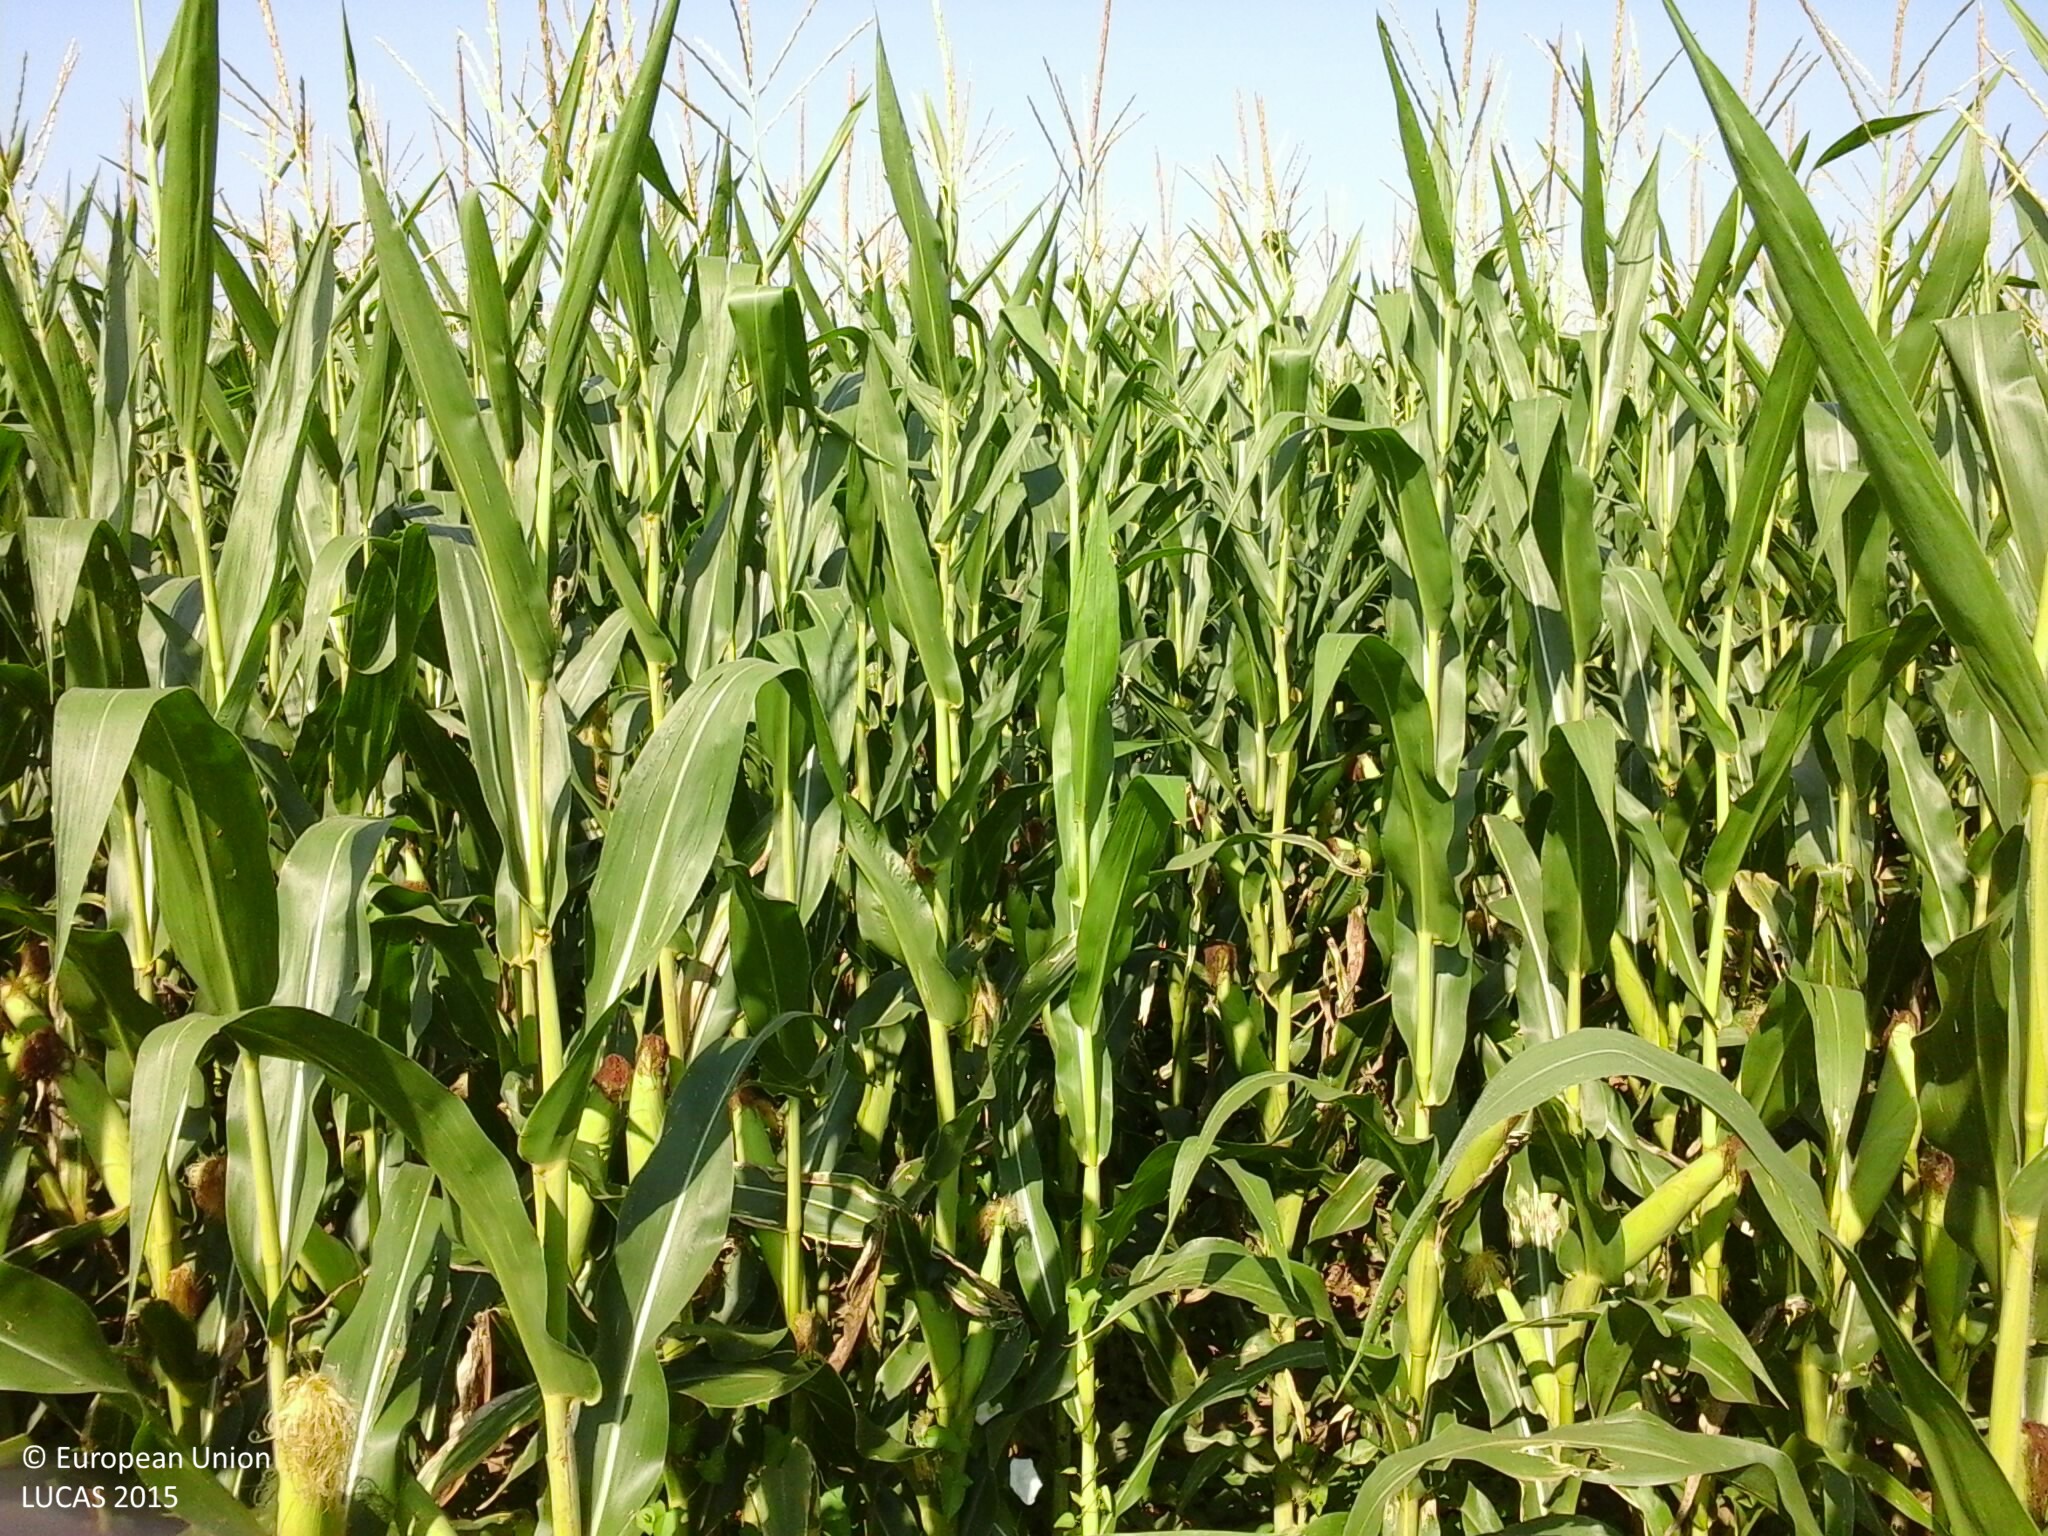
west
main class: Cropland
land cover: Maize
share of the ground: > 75 %
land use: Agriculture (excluding fallow land and kitchen gardens)
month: July
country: HU
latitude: 46.9690
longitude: 16.4558
